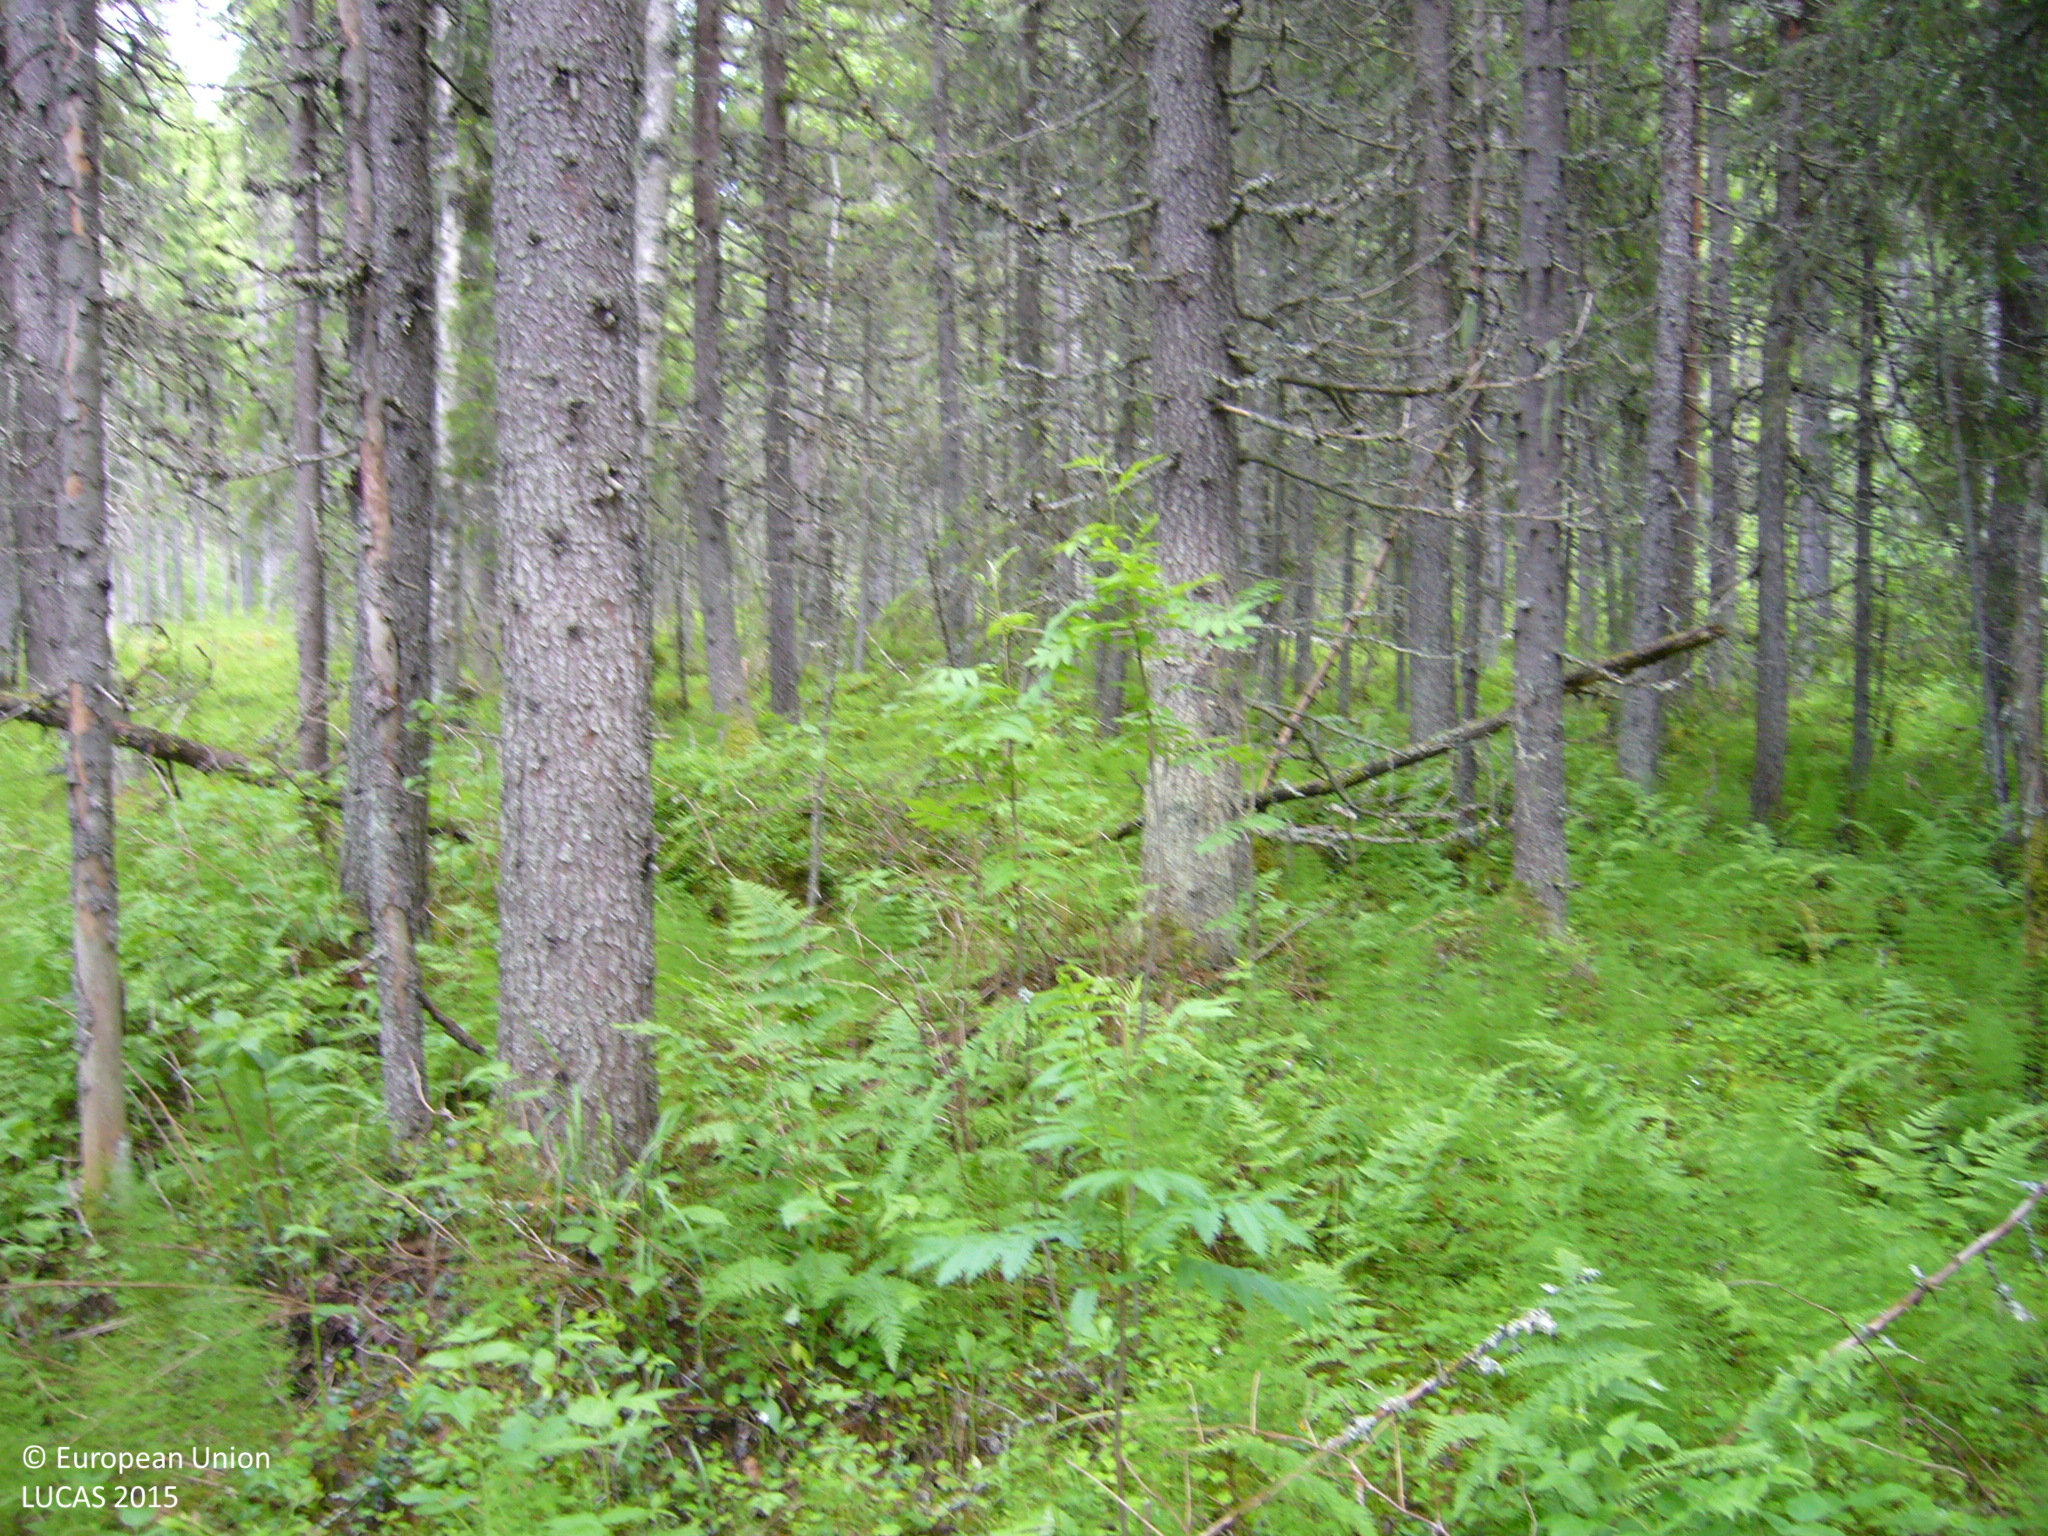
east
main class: Woodland
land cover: Spruce dominated coniferous woodland
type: boreal forest
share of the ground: > 75 %
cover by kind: coniferous forest trees 80 %, broadleaved forest trees 10 %, shrubs 10 %
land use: Forestry
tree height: > 5 m
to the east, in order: Spruce dominated coniferous woodland; Ditches and canals; Spruce dominated coniferous woodland
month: June
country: FI
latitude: 63.7060
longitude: 26.3683
